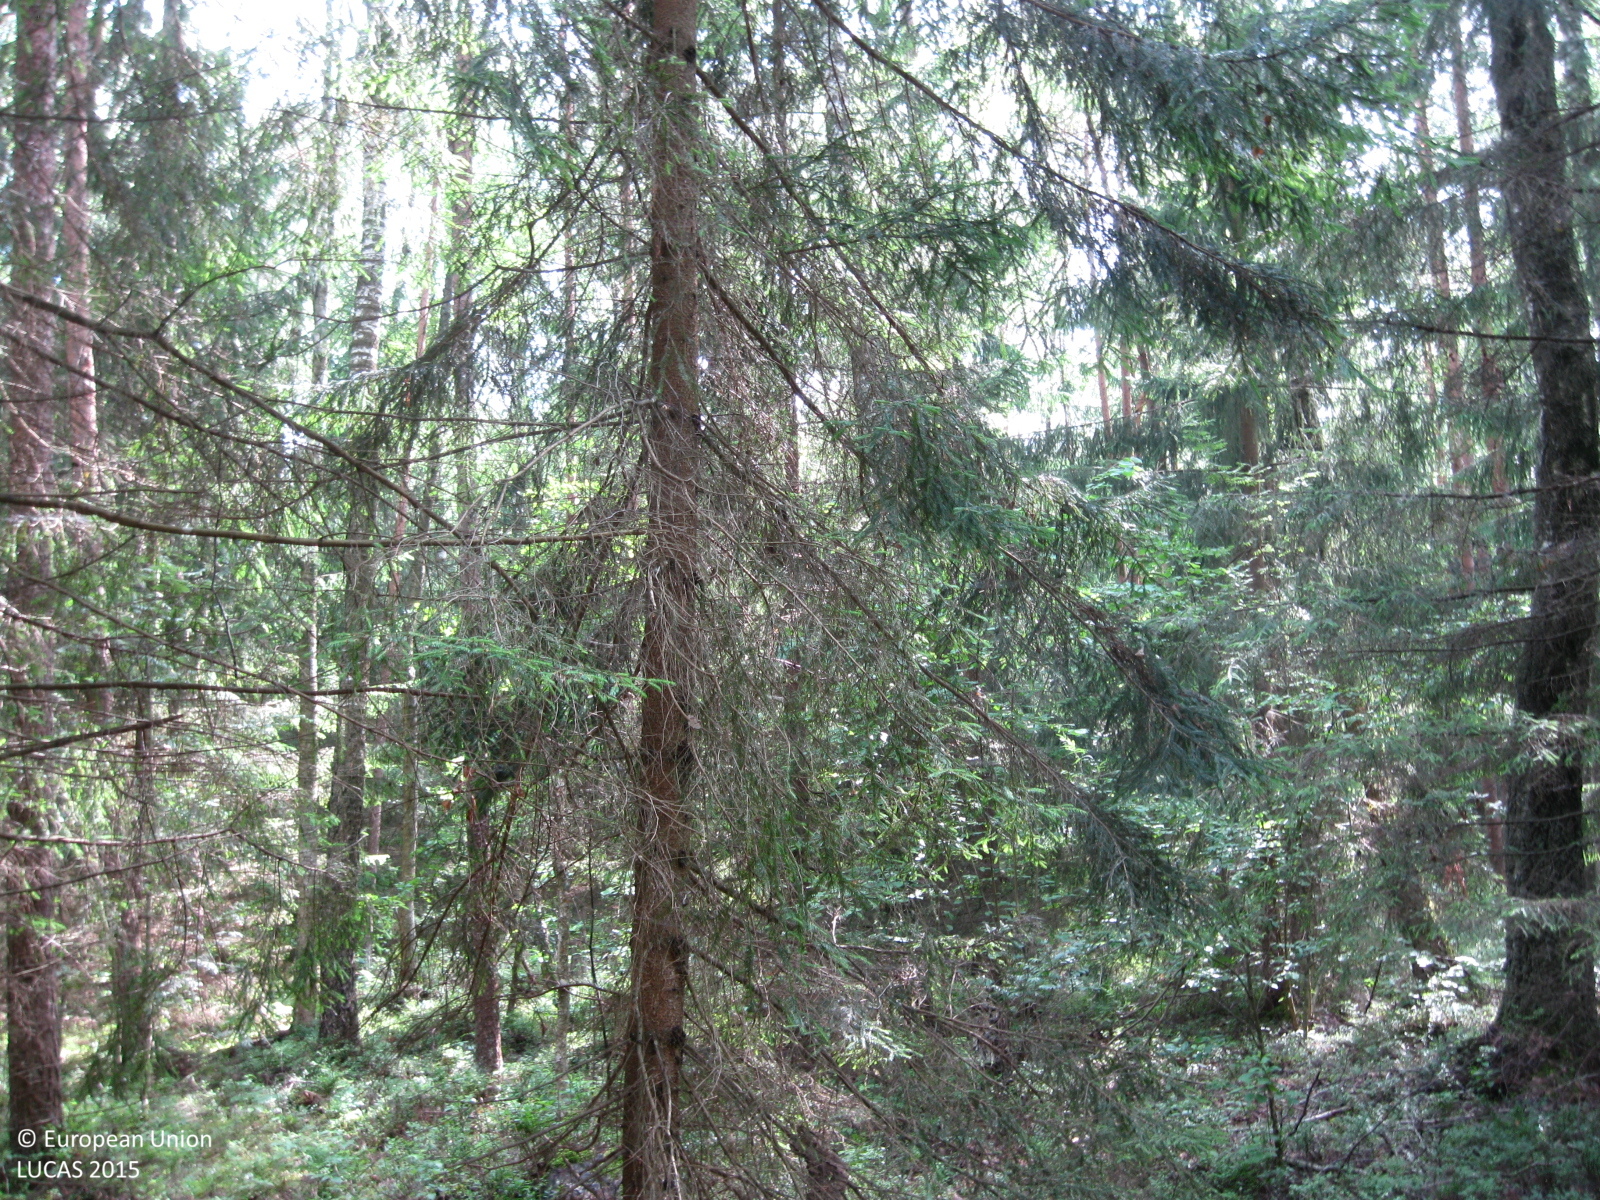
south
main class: Woodland
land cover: Other mixed woodland
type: hemiboreal forest and nemoral coniferous forest and mixed broadleaved-coniferous forest
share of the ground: > 75 %
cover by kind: coniferous forest trees 50 %, broadleaved forest trees 30 %, shrubs 10 %, lichens and mosses 10 %
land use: Forestry
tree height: > 5 m
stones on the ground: < 10 %
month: July
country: LT
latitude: 55.5574
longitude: 24.6735
